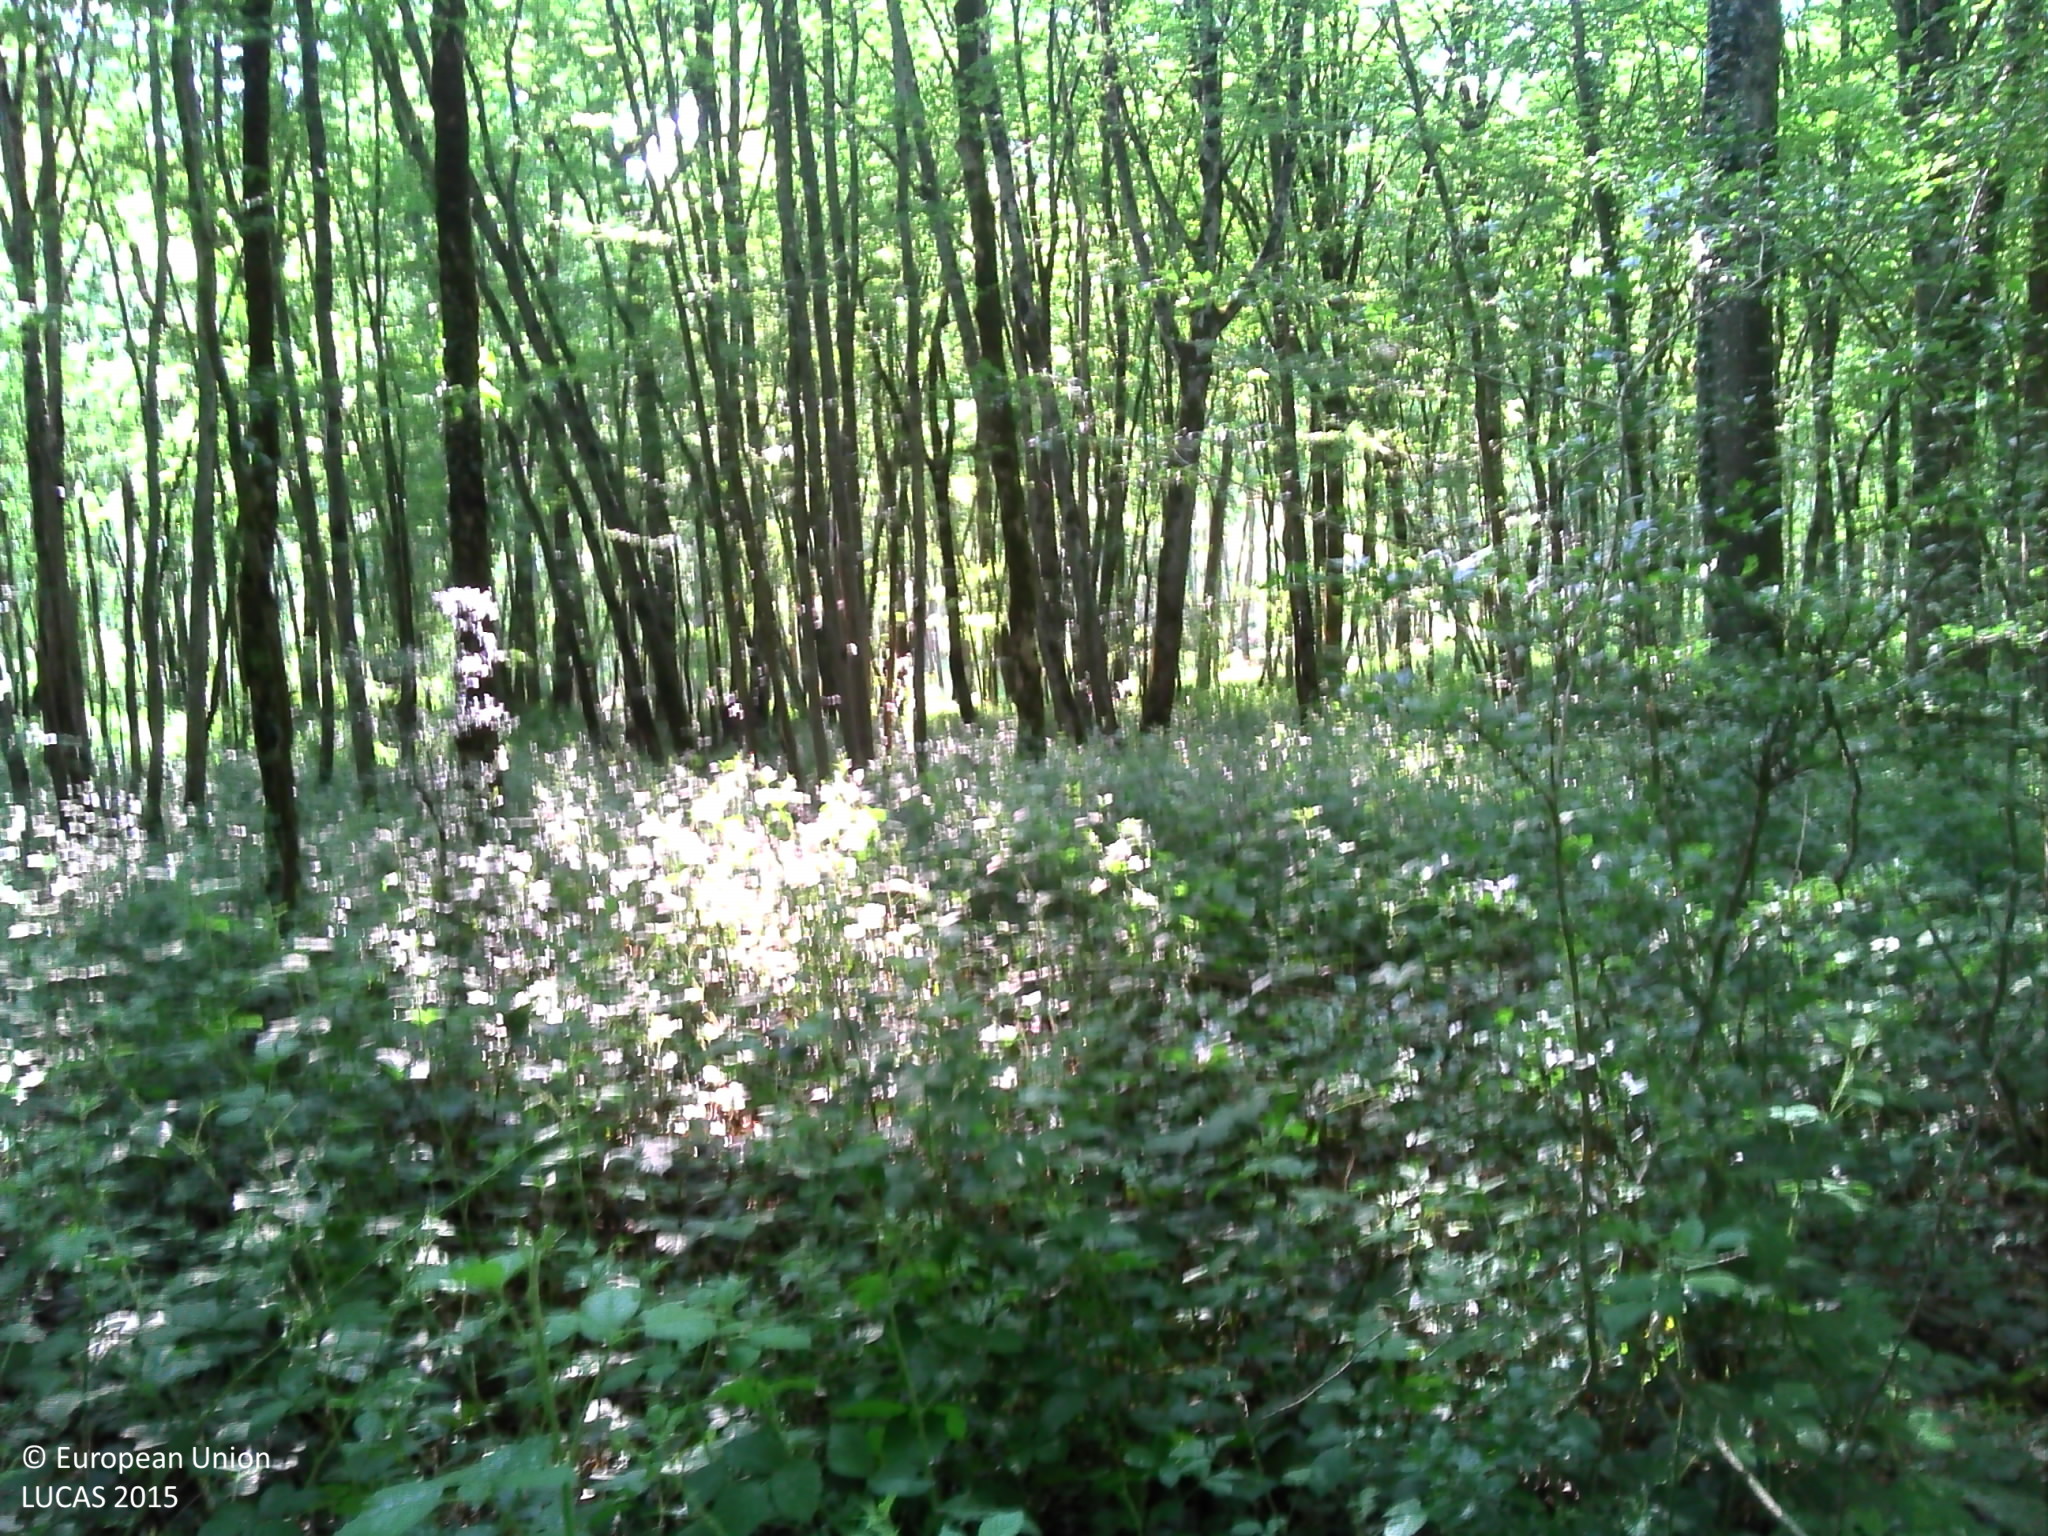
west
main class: Woodland
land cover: Broadleaved woodland
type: beech forest
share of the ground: > 75 %
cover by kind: broadleaved forest trees 95 %, herbaceous plants 5 %
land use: Forestry
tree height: > 5 m
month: June
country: FR
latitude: 47.6188
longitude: 6.2359
